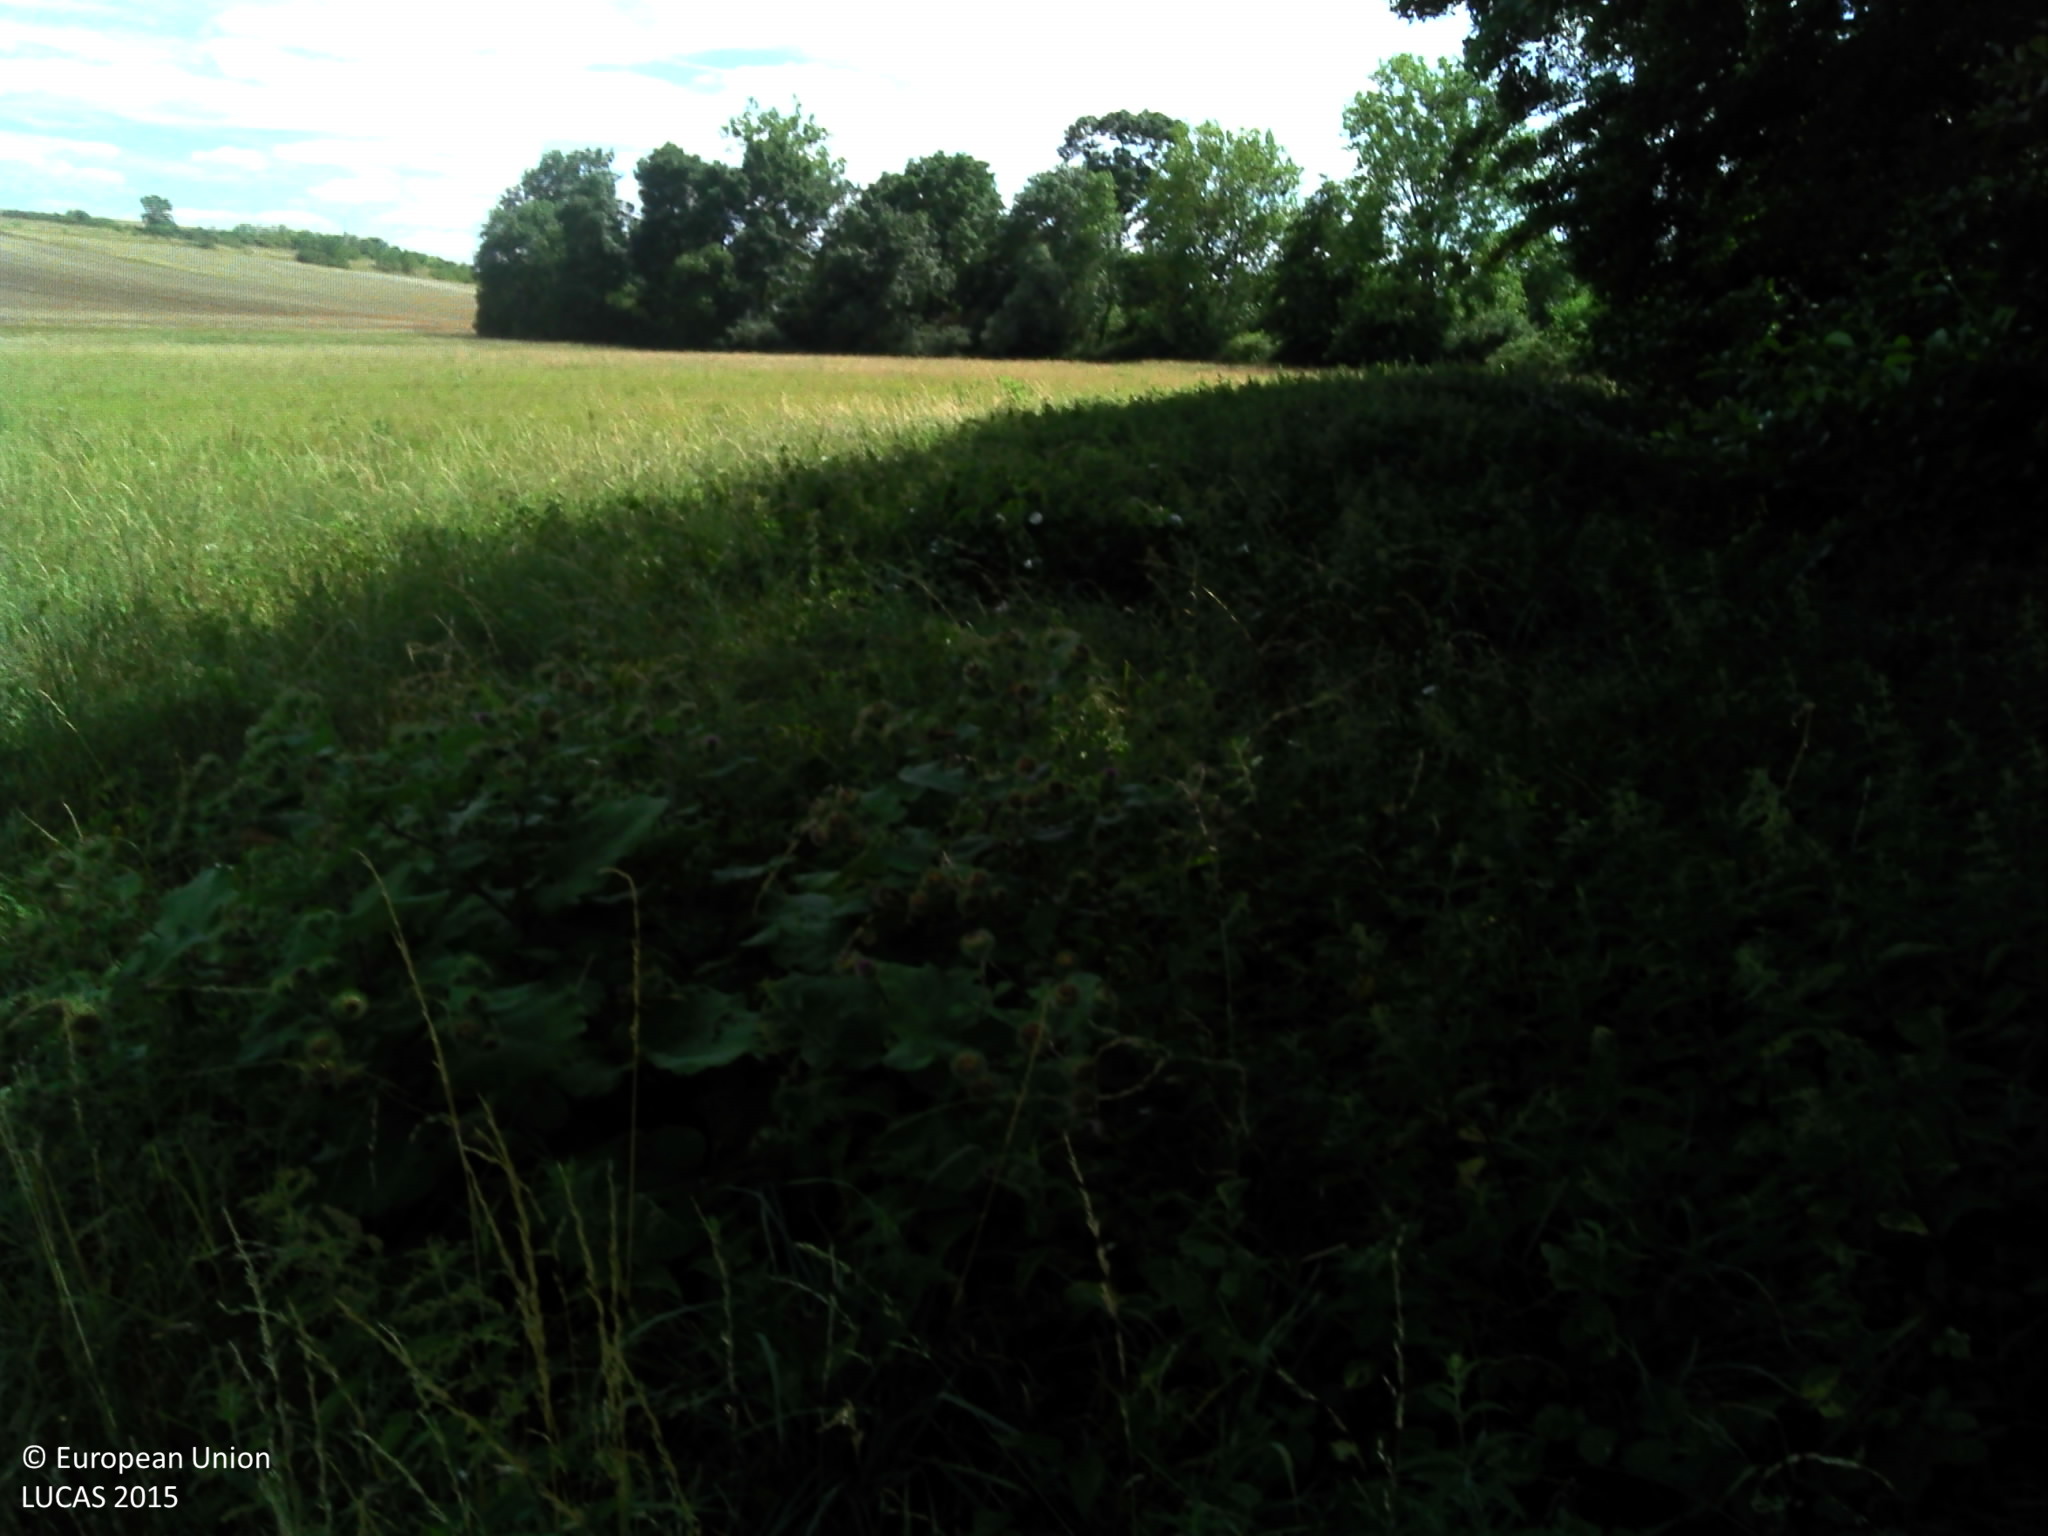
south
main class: Grassland
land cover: Grassland without tree/shrub cover
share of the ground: > 75 %
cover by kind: herbaceous plants 100 %
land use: Agriculture (excluding fallow land and kitchen gardens)
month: July
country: FR
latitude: 46.9826
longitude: 2.1166
